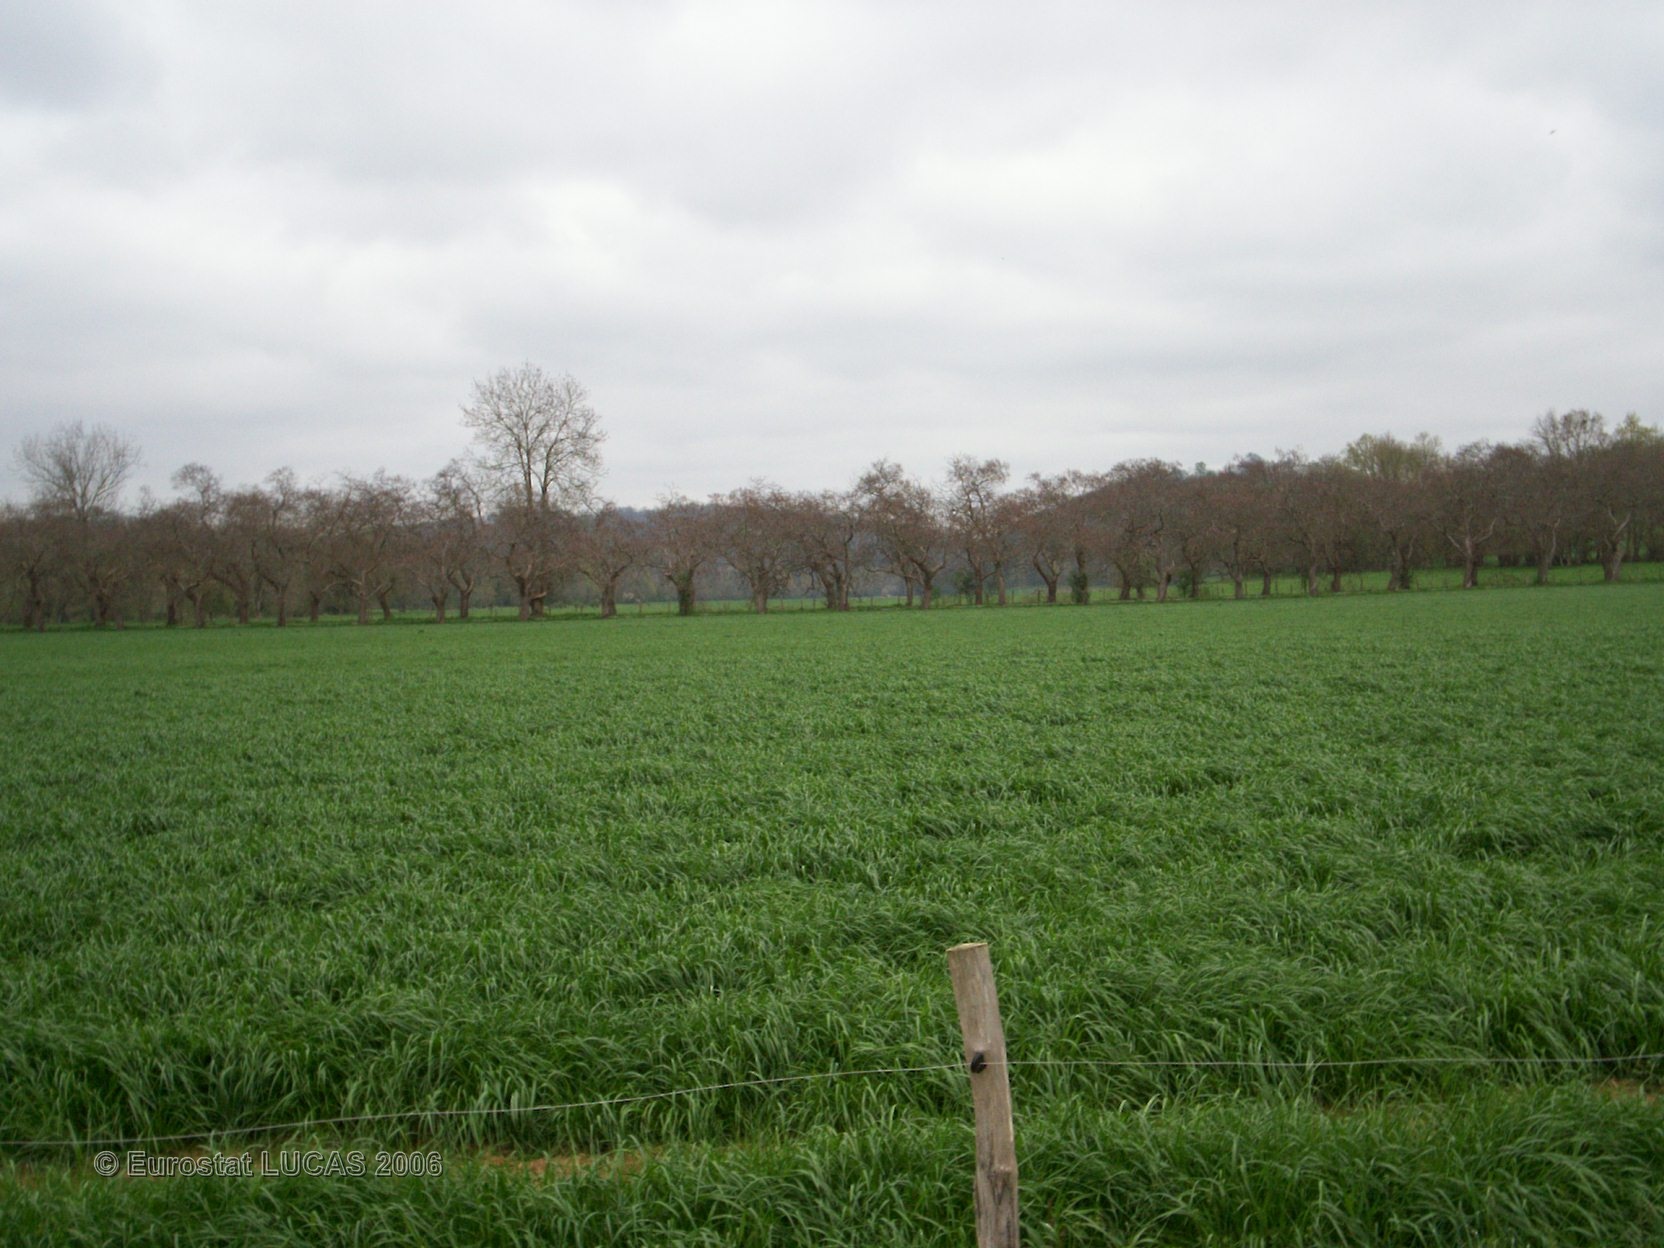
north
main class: Grassland
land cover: Grassland without tree/shrub cover
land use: Agriculture (excluding fallow land and kitchen gardens)
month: April
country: FR
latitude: 43.0455
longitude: 0.9316
